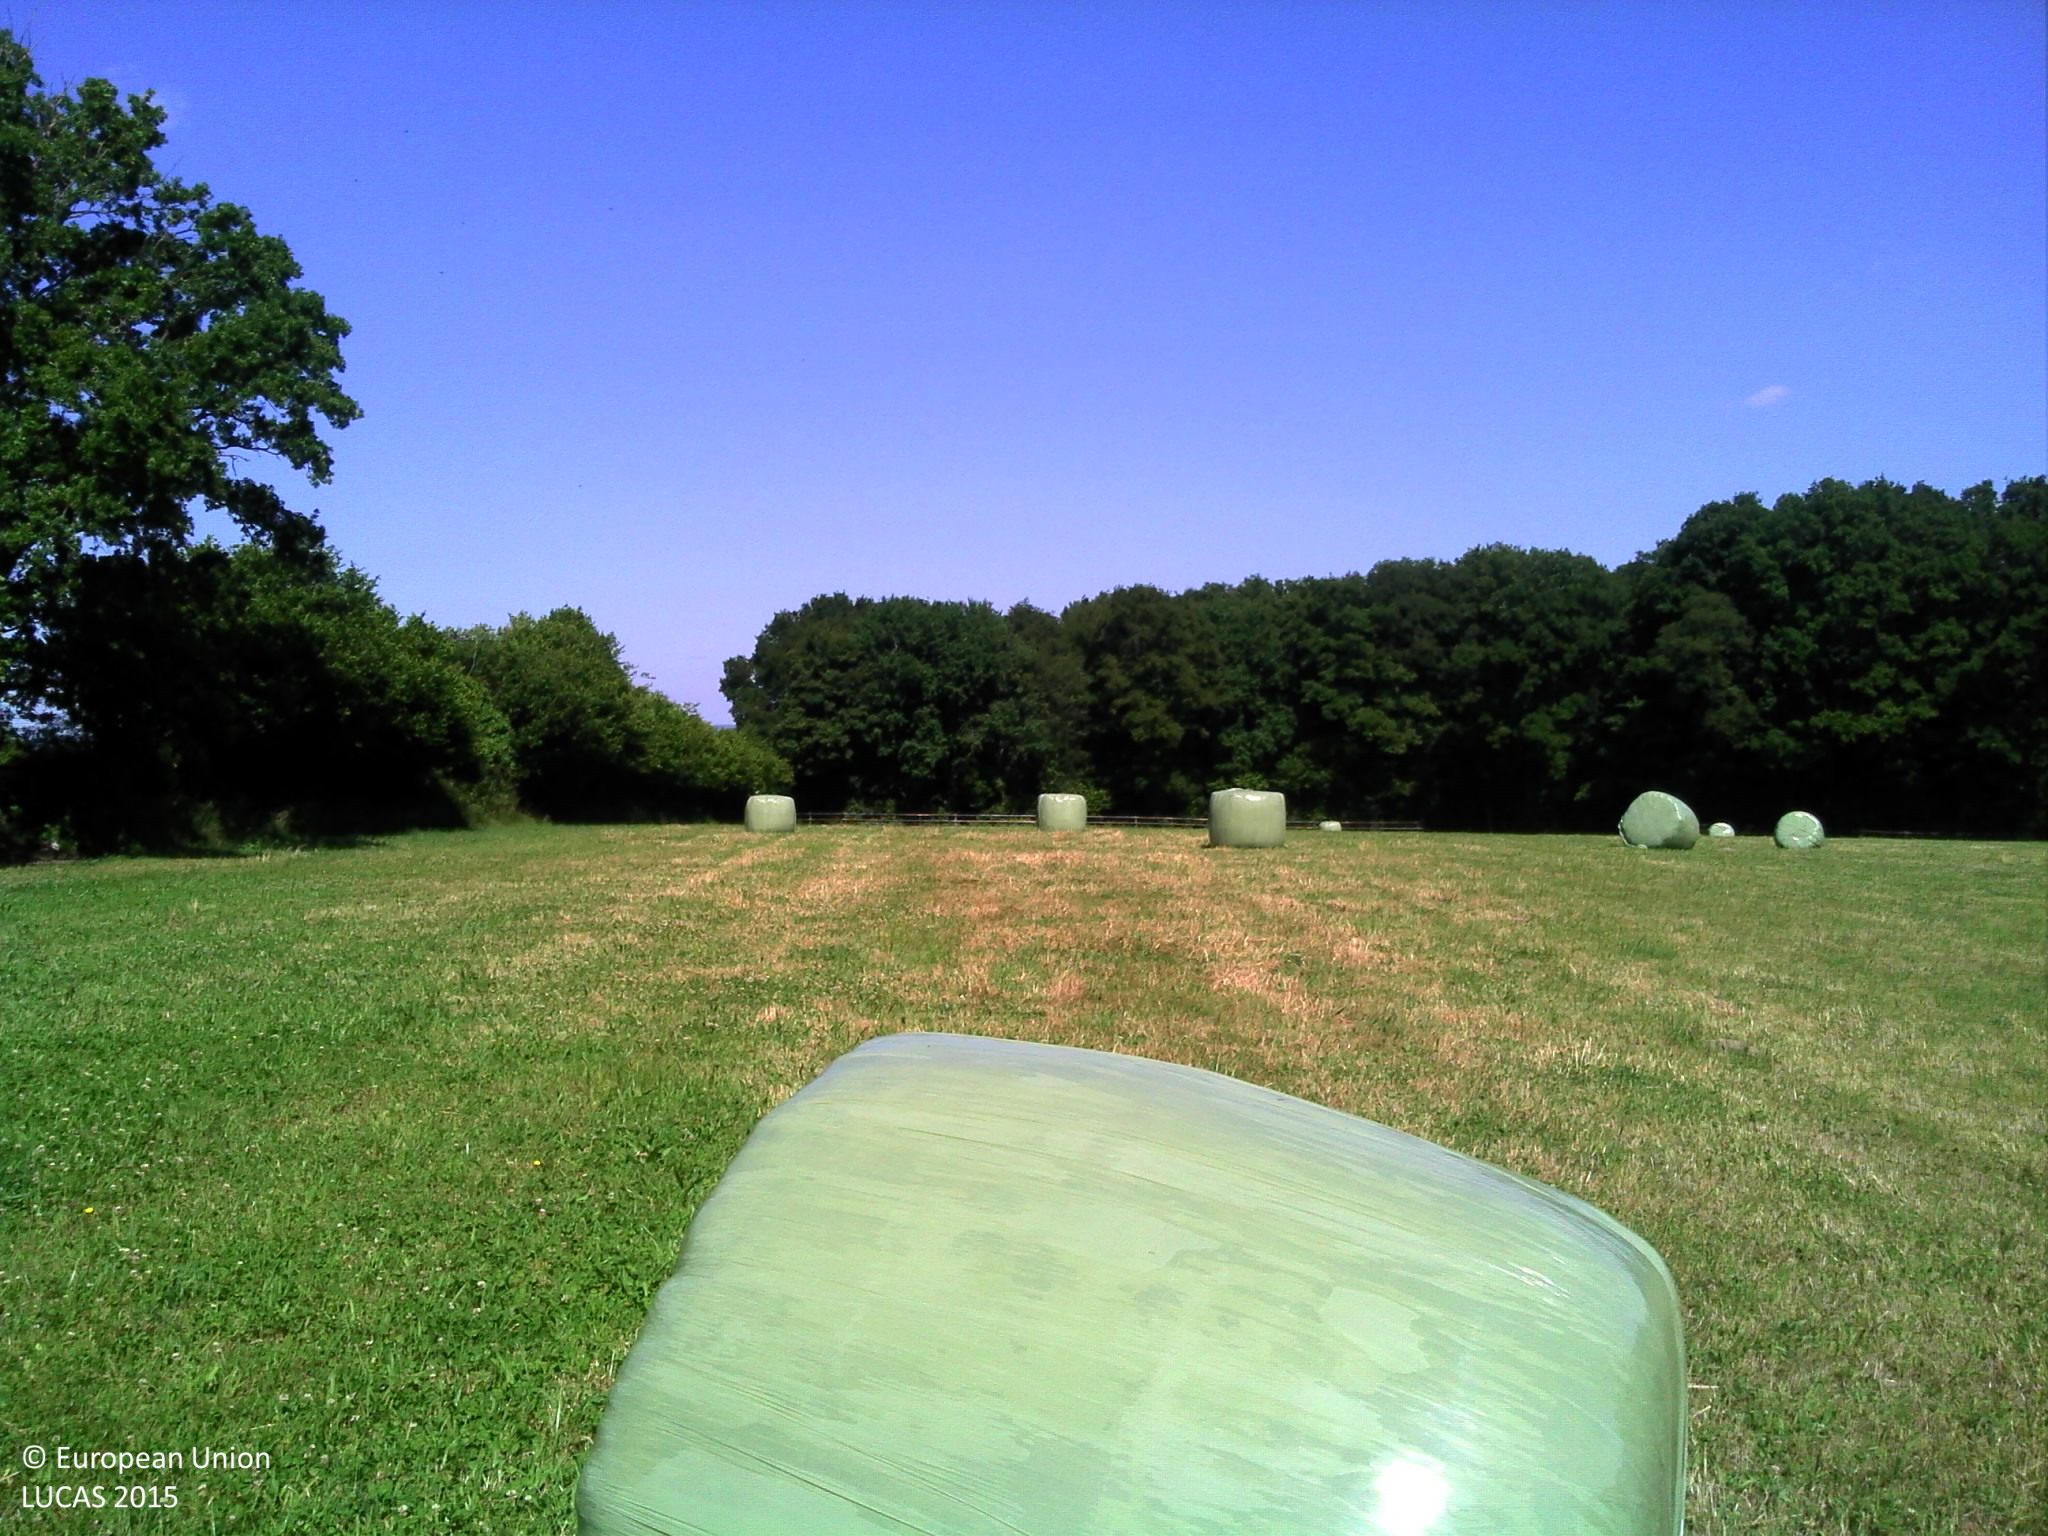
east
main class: Grassland
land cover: Grassland without tree/shrub cover
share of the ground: > 75 %
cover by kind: herbaceous plants 100 %
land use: Agriculture (excluding fallow land and kitchen gardens)
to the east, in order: Grassland without tree/shrub cover; Fences; Broadleaved woodland; Ditches and canals; Spruce dominated coniferous woodland; Ditches and canals; Broadleaved woodland
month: June
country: FR
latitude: 48.5558
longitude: 0.0943
